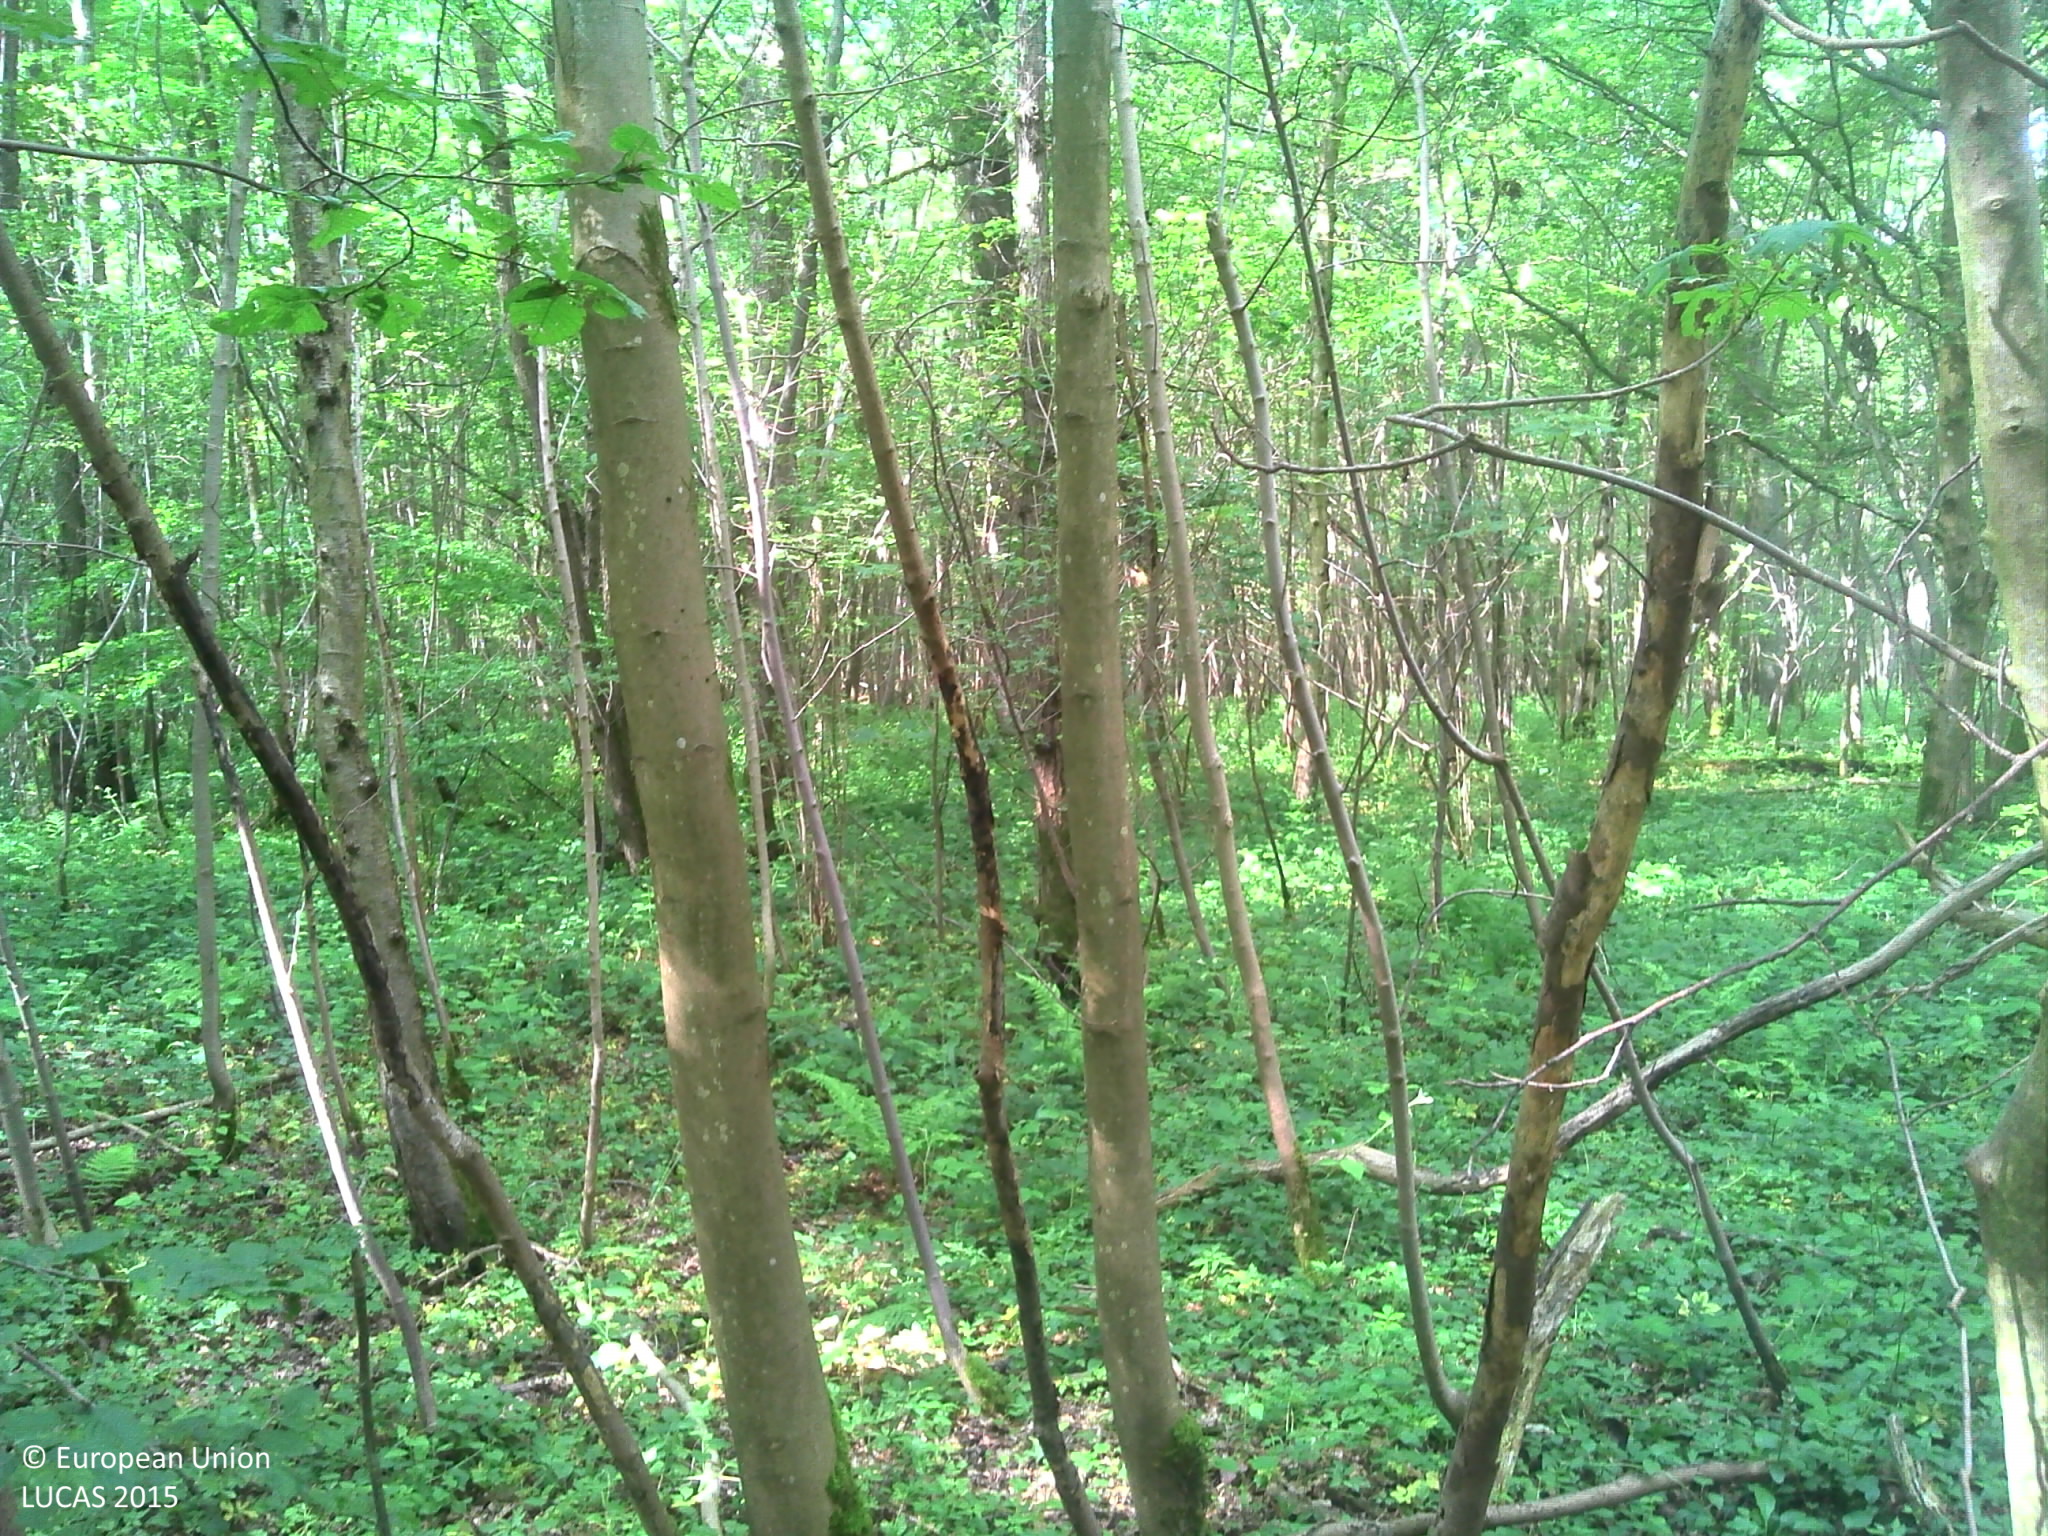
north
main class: Woodland
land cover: Broadleaved woodland
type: mesophytic deciduous forest
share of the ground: > 75 %
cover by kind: broadleaved forest trees 85 %, herbaceous plants 15 %
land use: Forestry
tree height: > 5 m
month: June
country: FR
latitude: 49.6769
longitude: 3.2426
